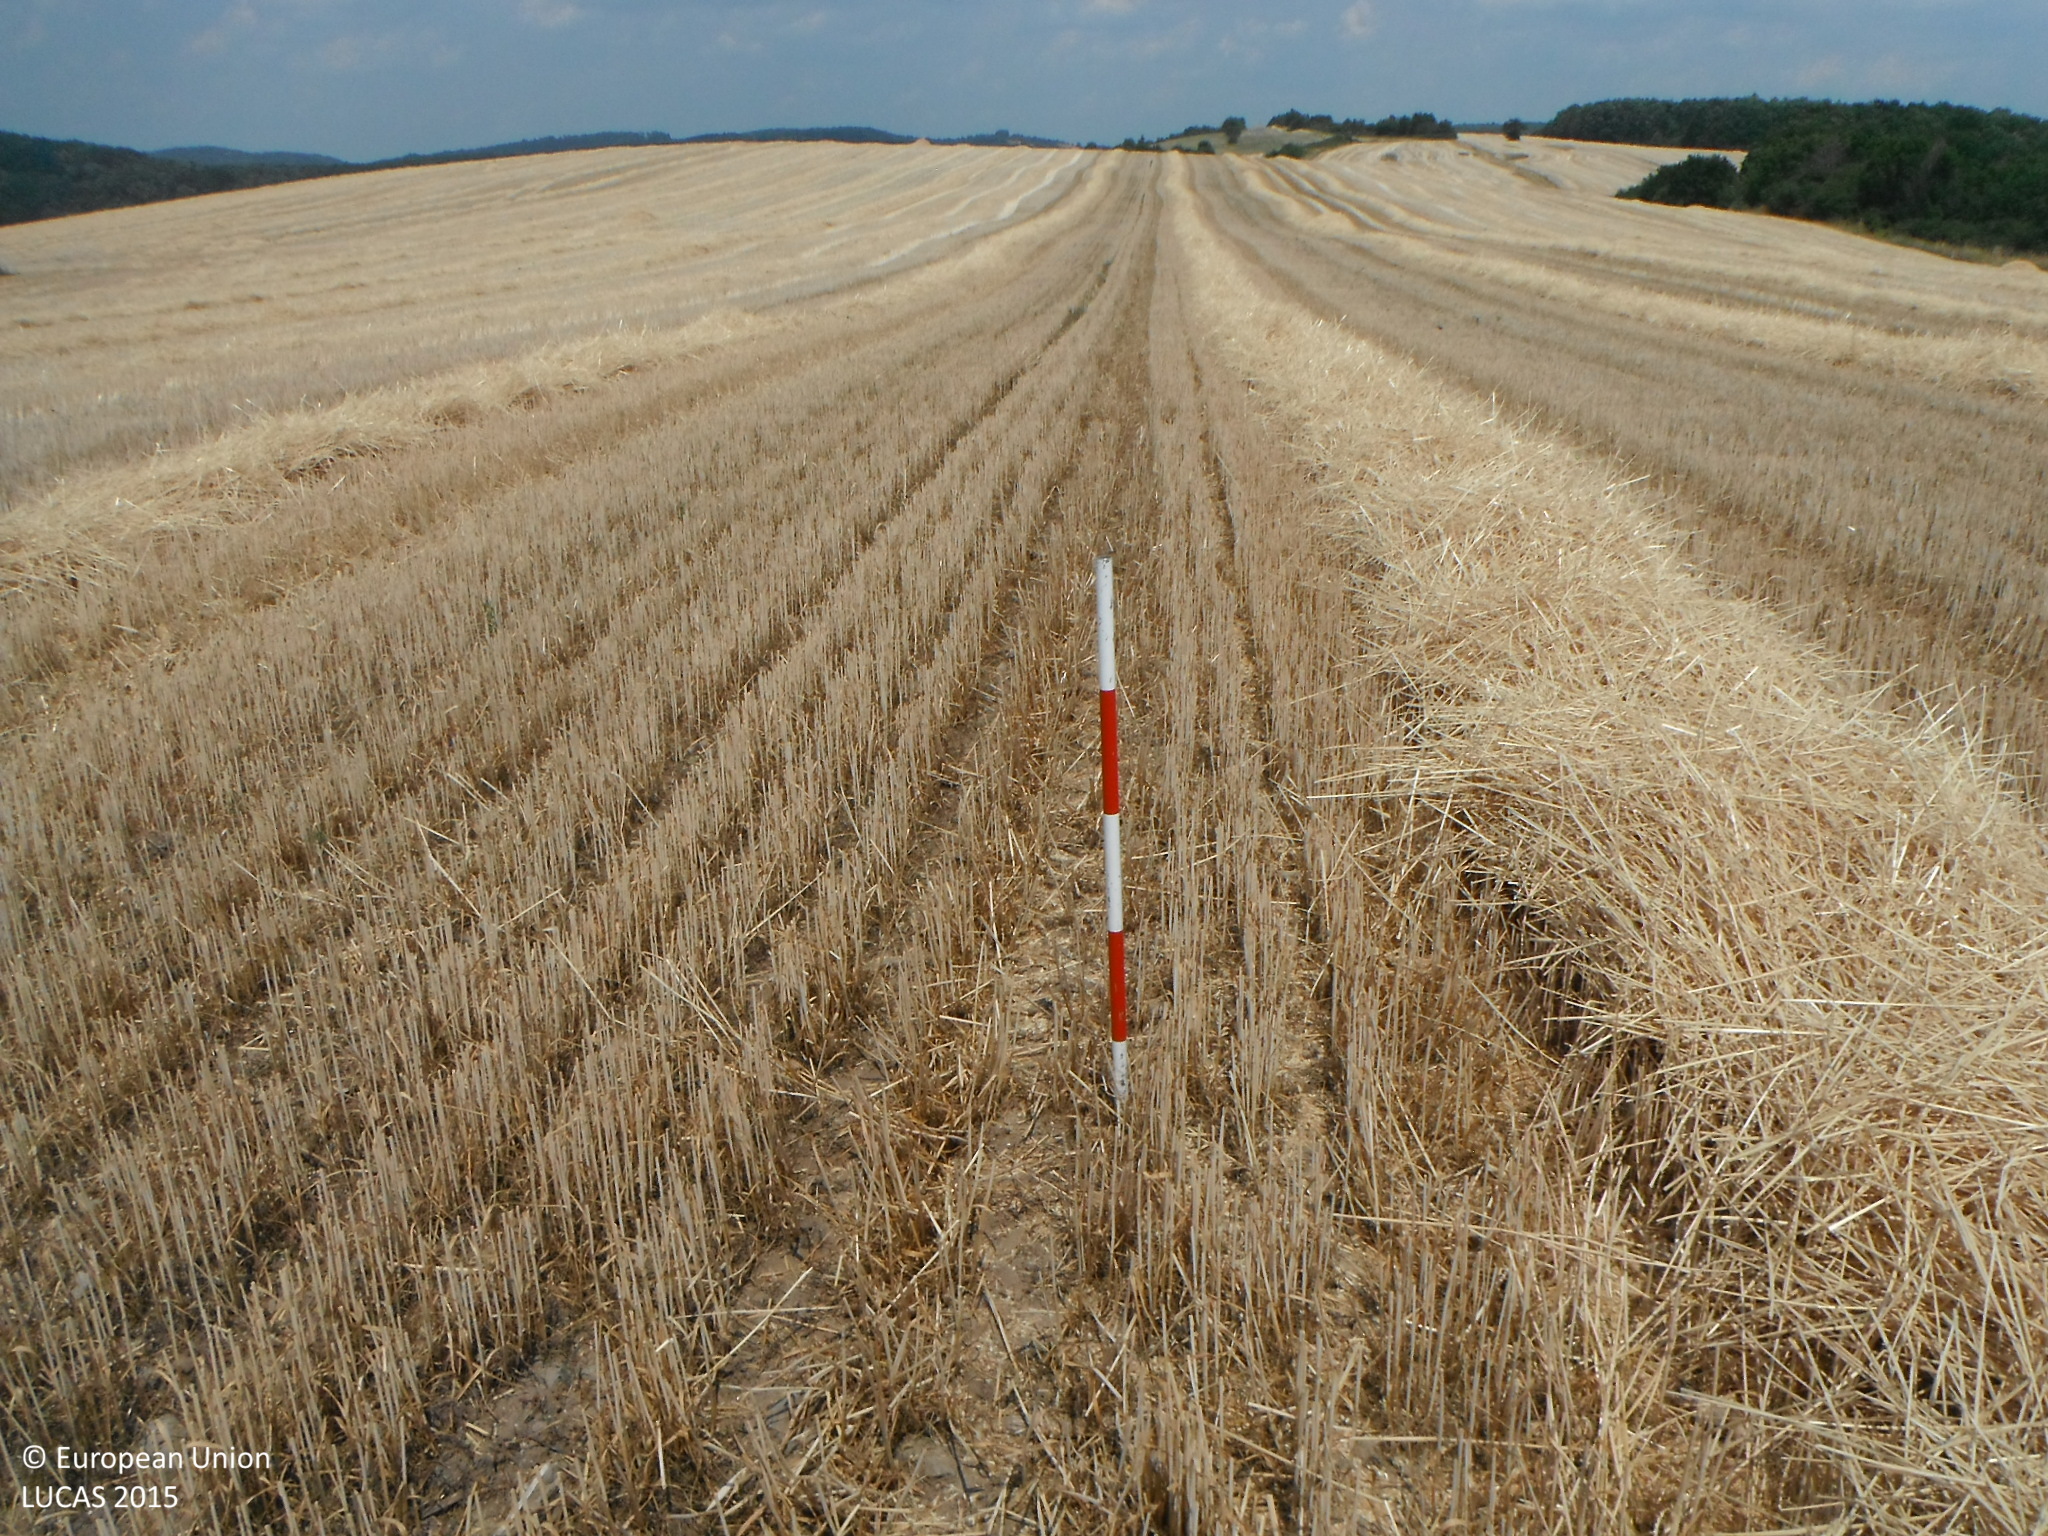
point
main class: Cropland
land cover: Common wheat
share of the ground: > 75 %
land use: Agriculture (excluding fallow land and kitchen gardens)
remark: Harvested field
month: July
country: SK
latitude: 48.3510
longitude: 19.1299
